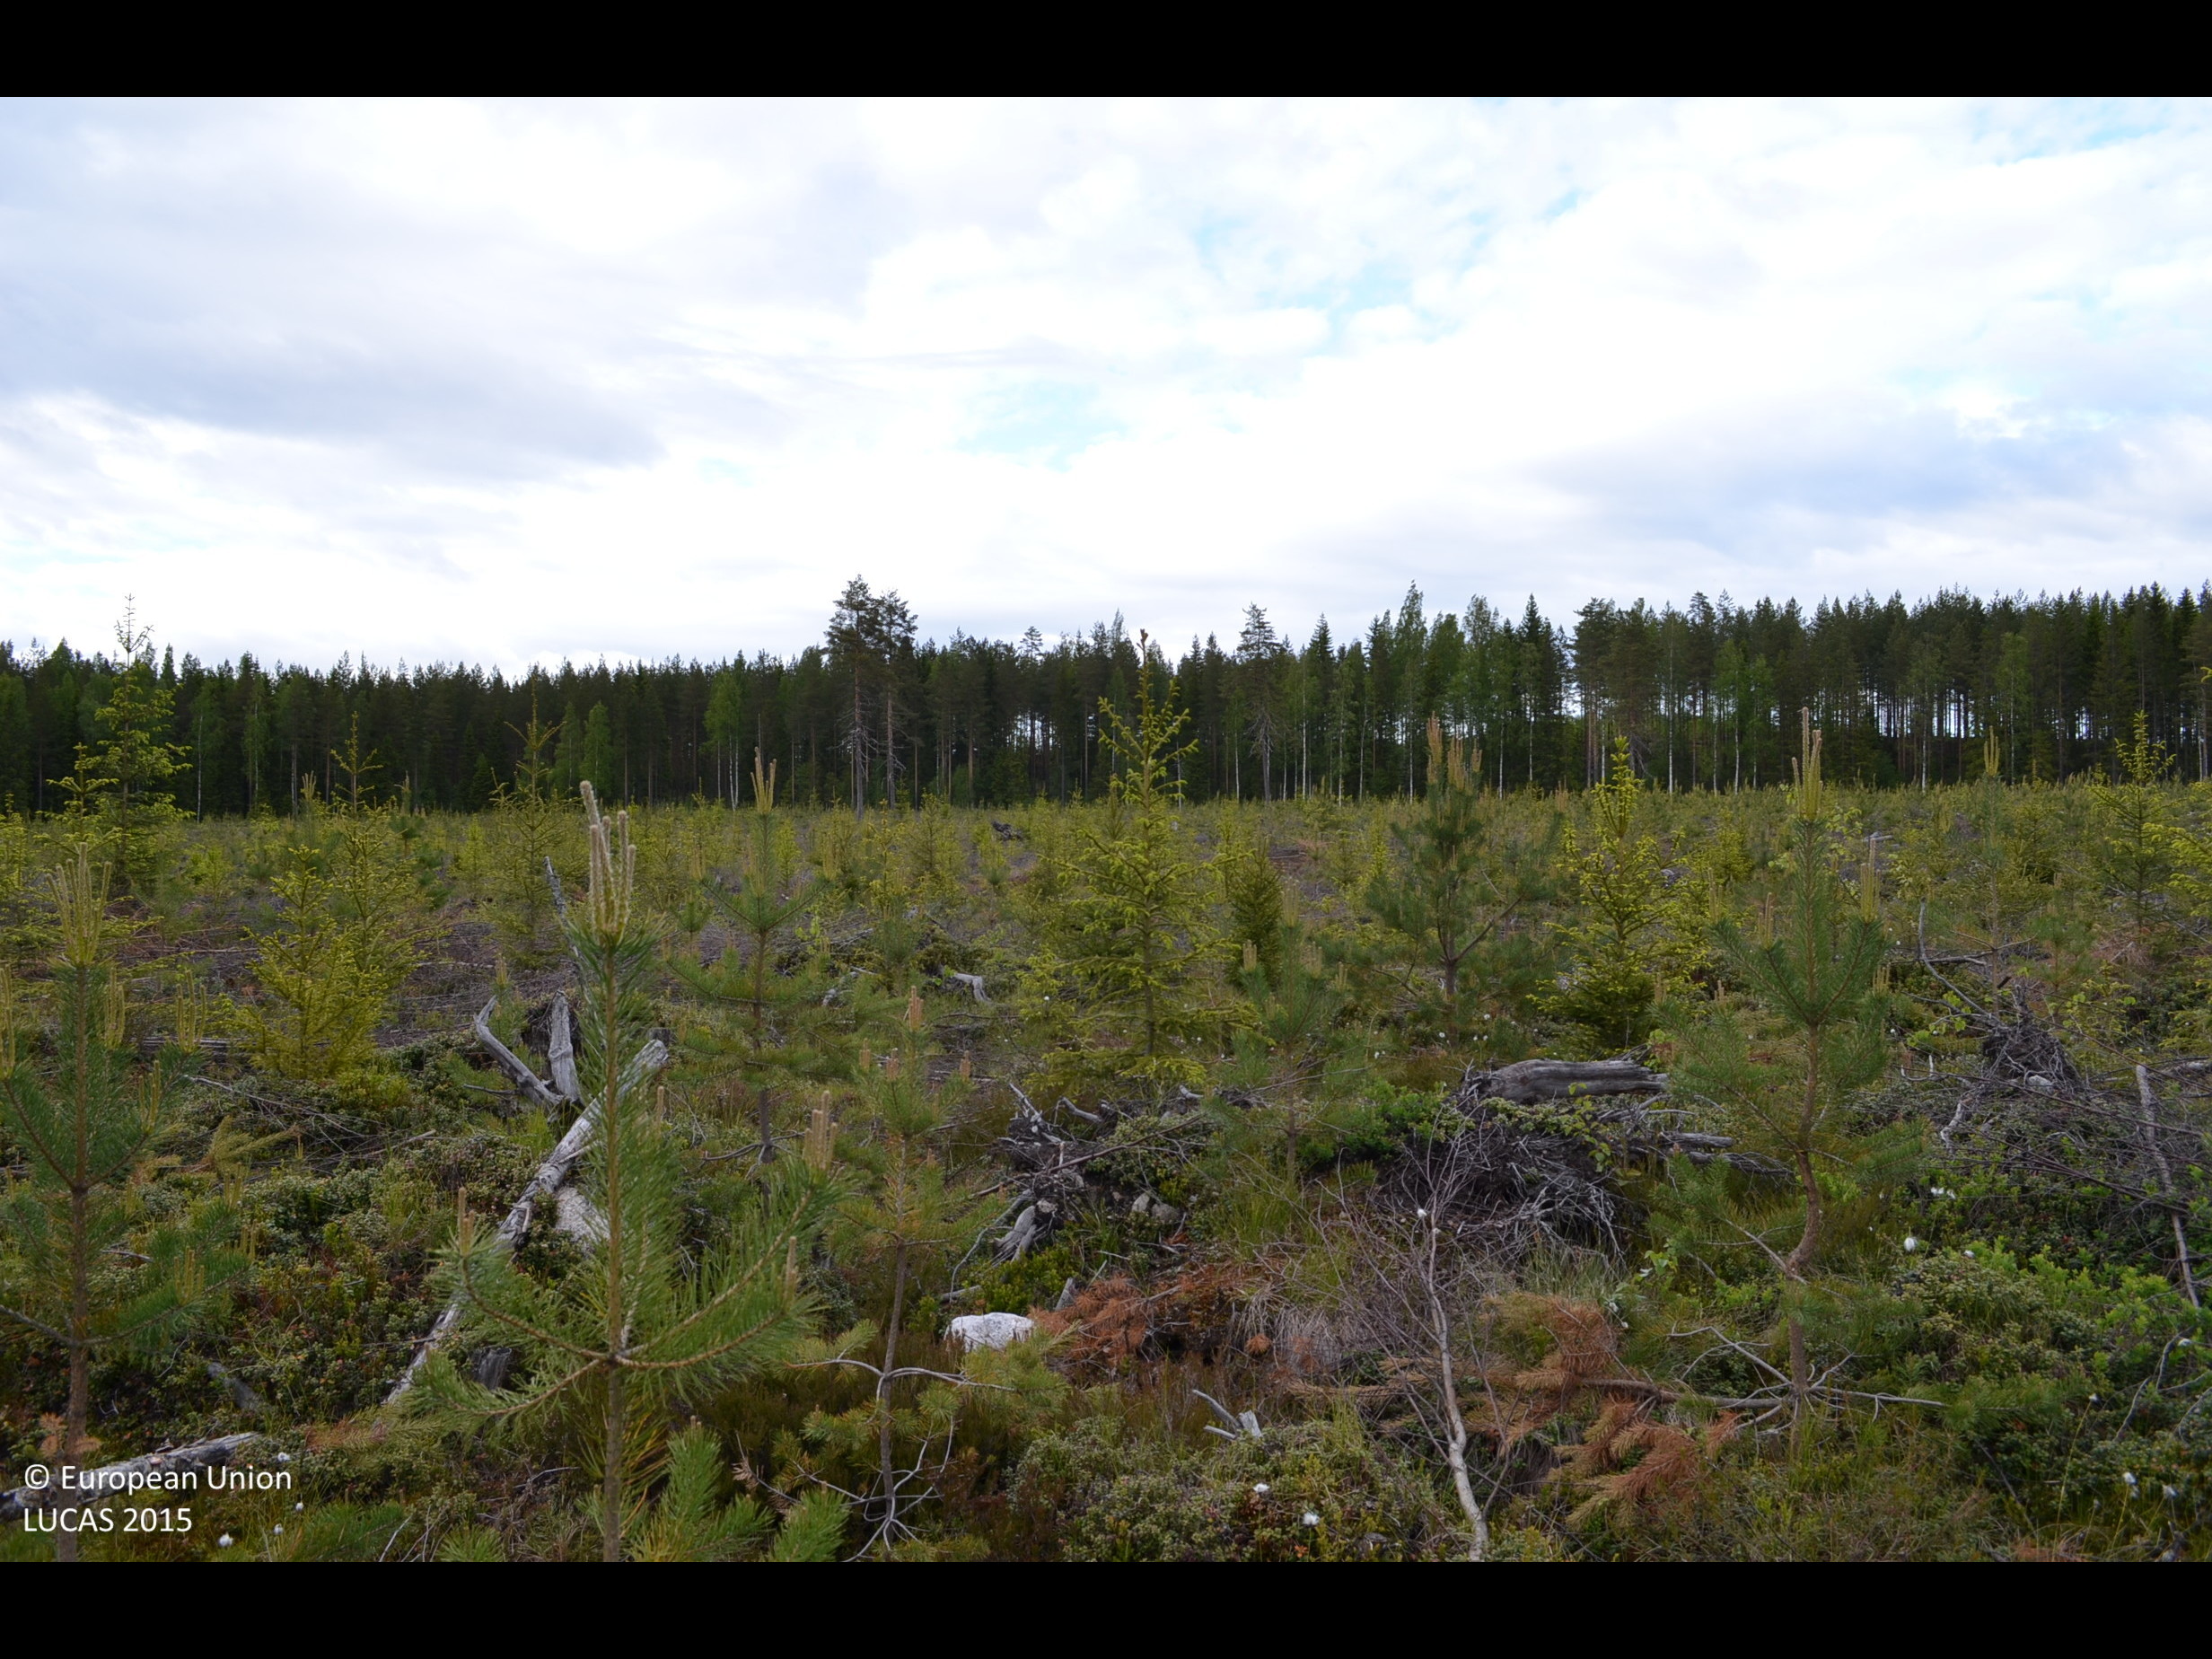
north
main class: Woodland
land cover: Other coniferous woodland
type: boreal forest
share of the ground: 25 - 50 %
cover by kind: shrubs 45 %, coniferous forest trees 35 %, lichens and mosses 10 %, herbaceous plants 5 %
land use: Forestry
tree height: < 5 m
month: June
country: FI
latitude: 61.9019
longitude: 23.3779
